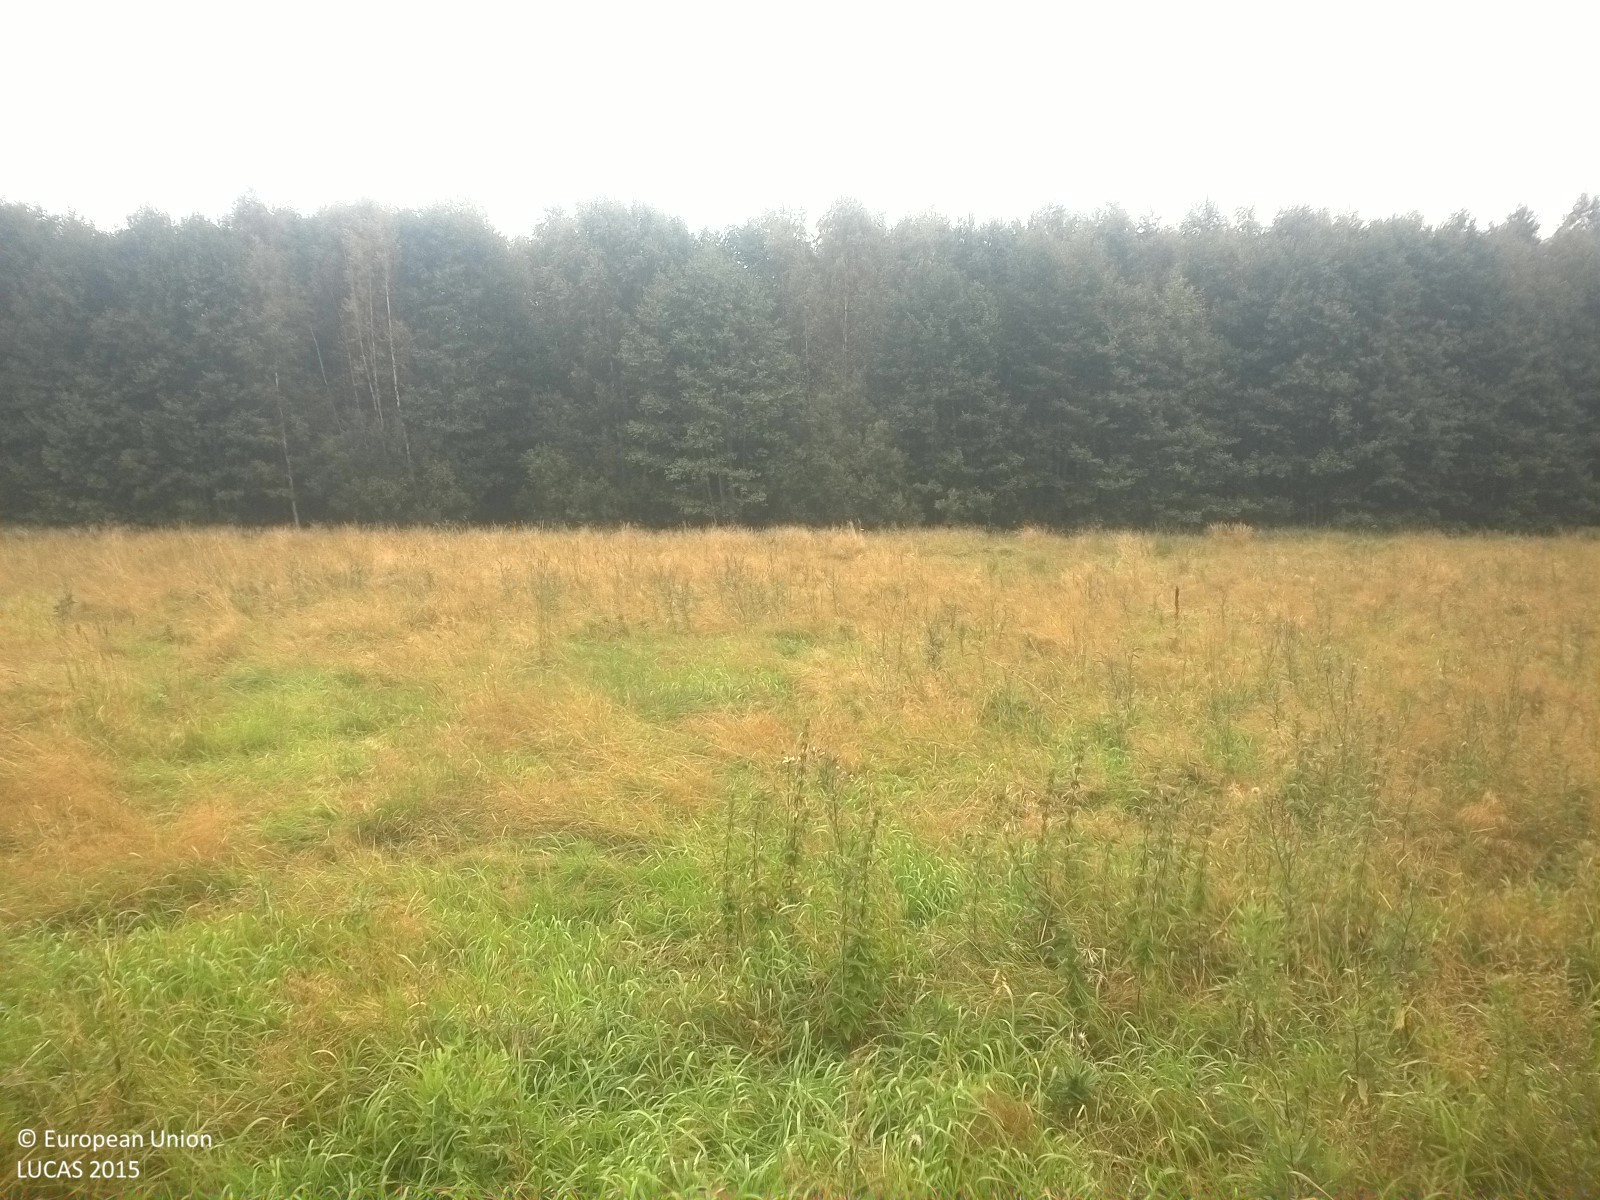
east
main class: Grassland
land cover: Grassland without tree/shrub cover
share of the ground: > 75 %
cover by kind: herbaceous plants 100 %
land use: Agriculture (excluding fallow land and kitchen gardens)
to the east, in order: Grassland without tree/shrub cover; Broadleaved woodland; Ditches and canals; Broadleaved woodland; Ditches and canals; Grass margins; Paved roads, cycling and walking lanes; Grassland without tree/shrub cover; Broadleaved woodland; Ditches and canals; Grass margins; Paved roads, cycling and walking lanes; Grass margins
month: September
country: SE
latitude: 59.3725
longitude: 15.4292
